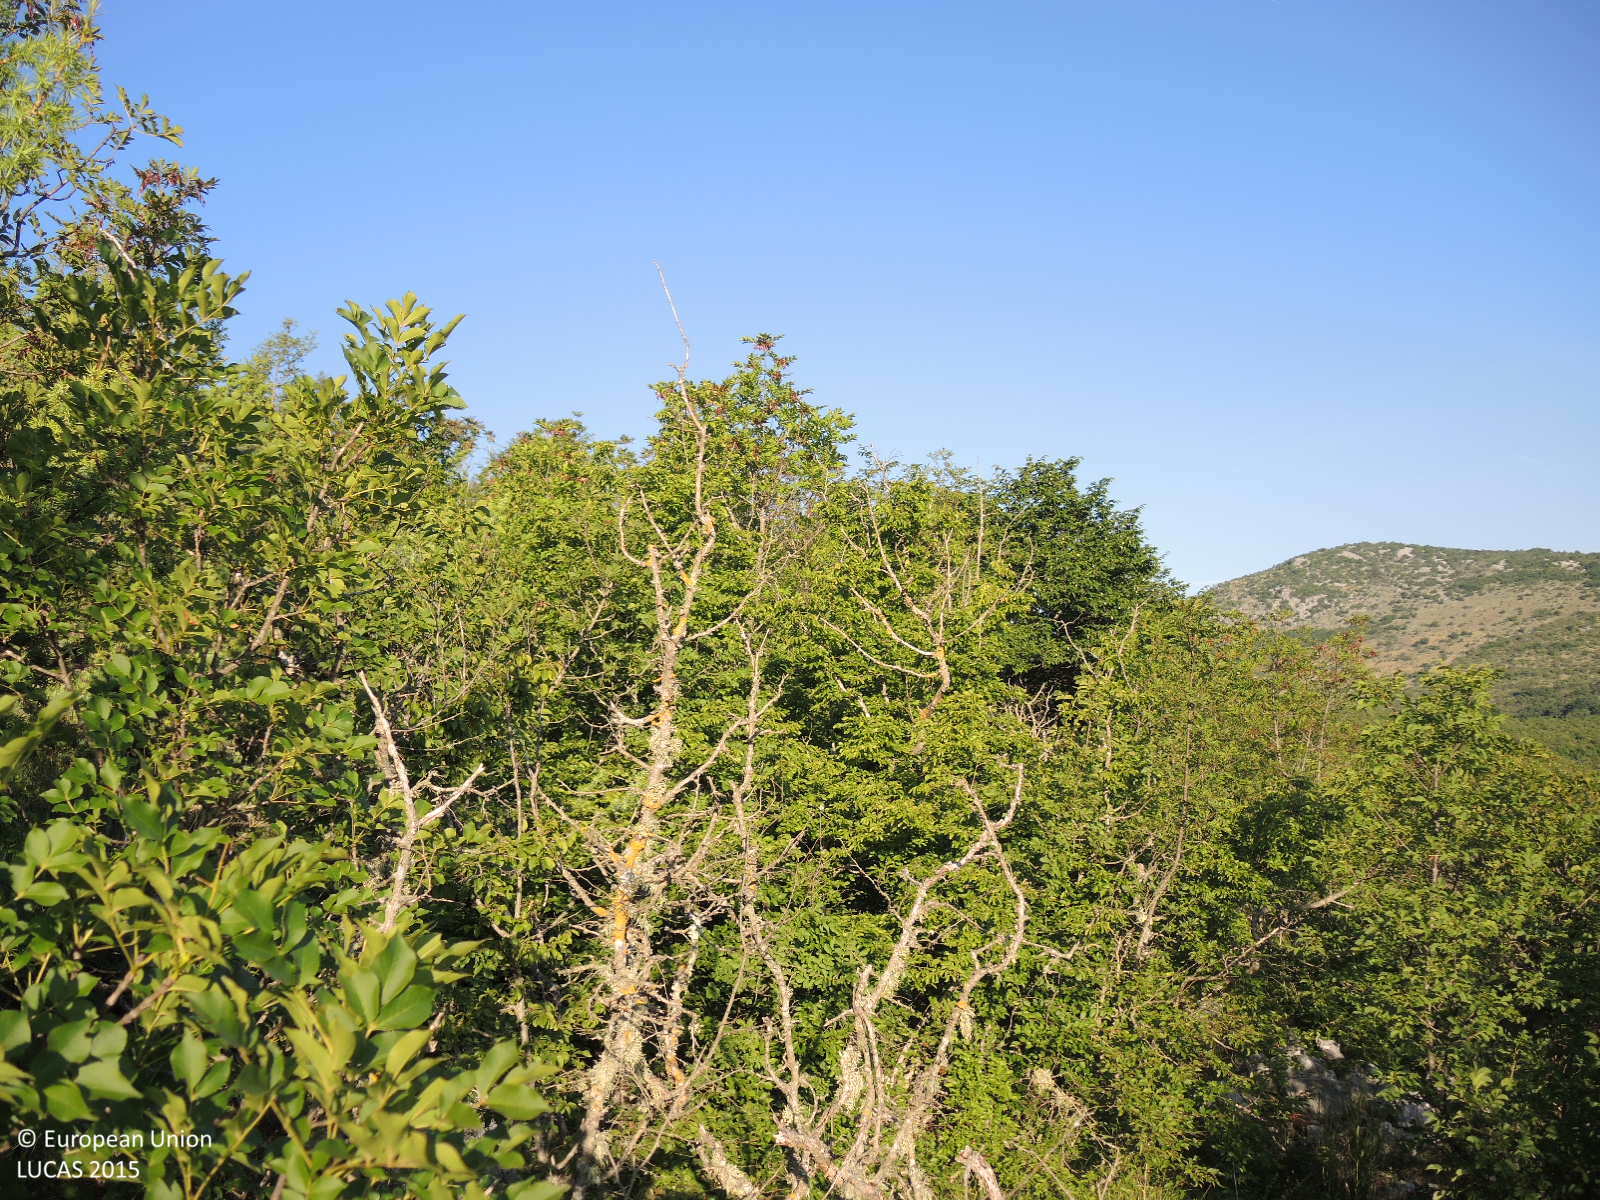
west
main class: Woodland
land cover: Broadleaved woodland
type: thermophilous deciduous forest
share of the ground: > 75 %
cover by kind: broadleaved forest trees 50 %, shrubs 30 %, consolidated bare surface 10 %, unconsolidated bare surface 10 %
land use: Semi-natural and natural areas not in use
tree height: < 5 m
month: June
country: HR
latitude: 43.6614
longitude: 16.1541
